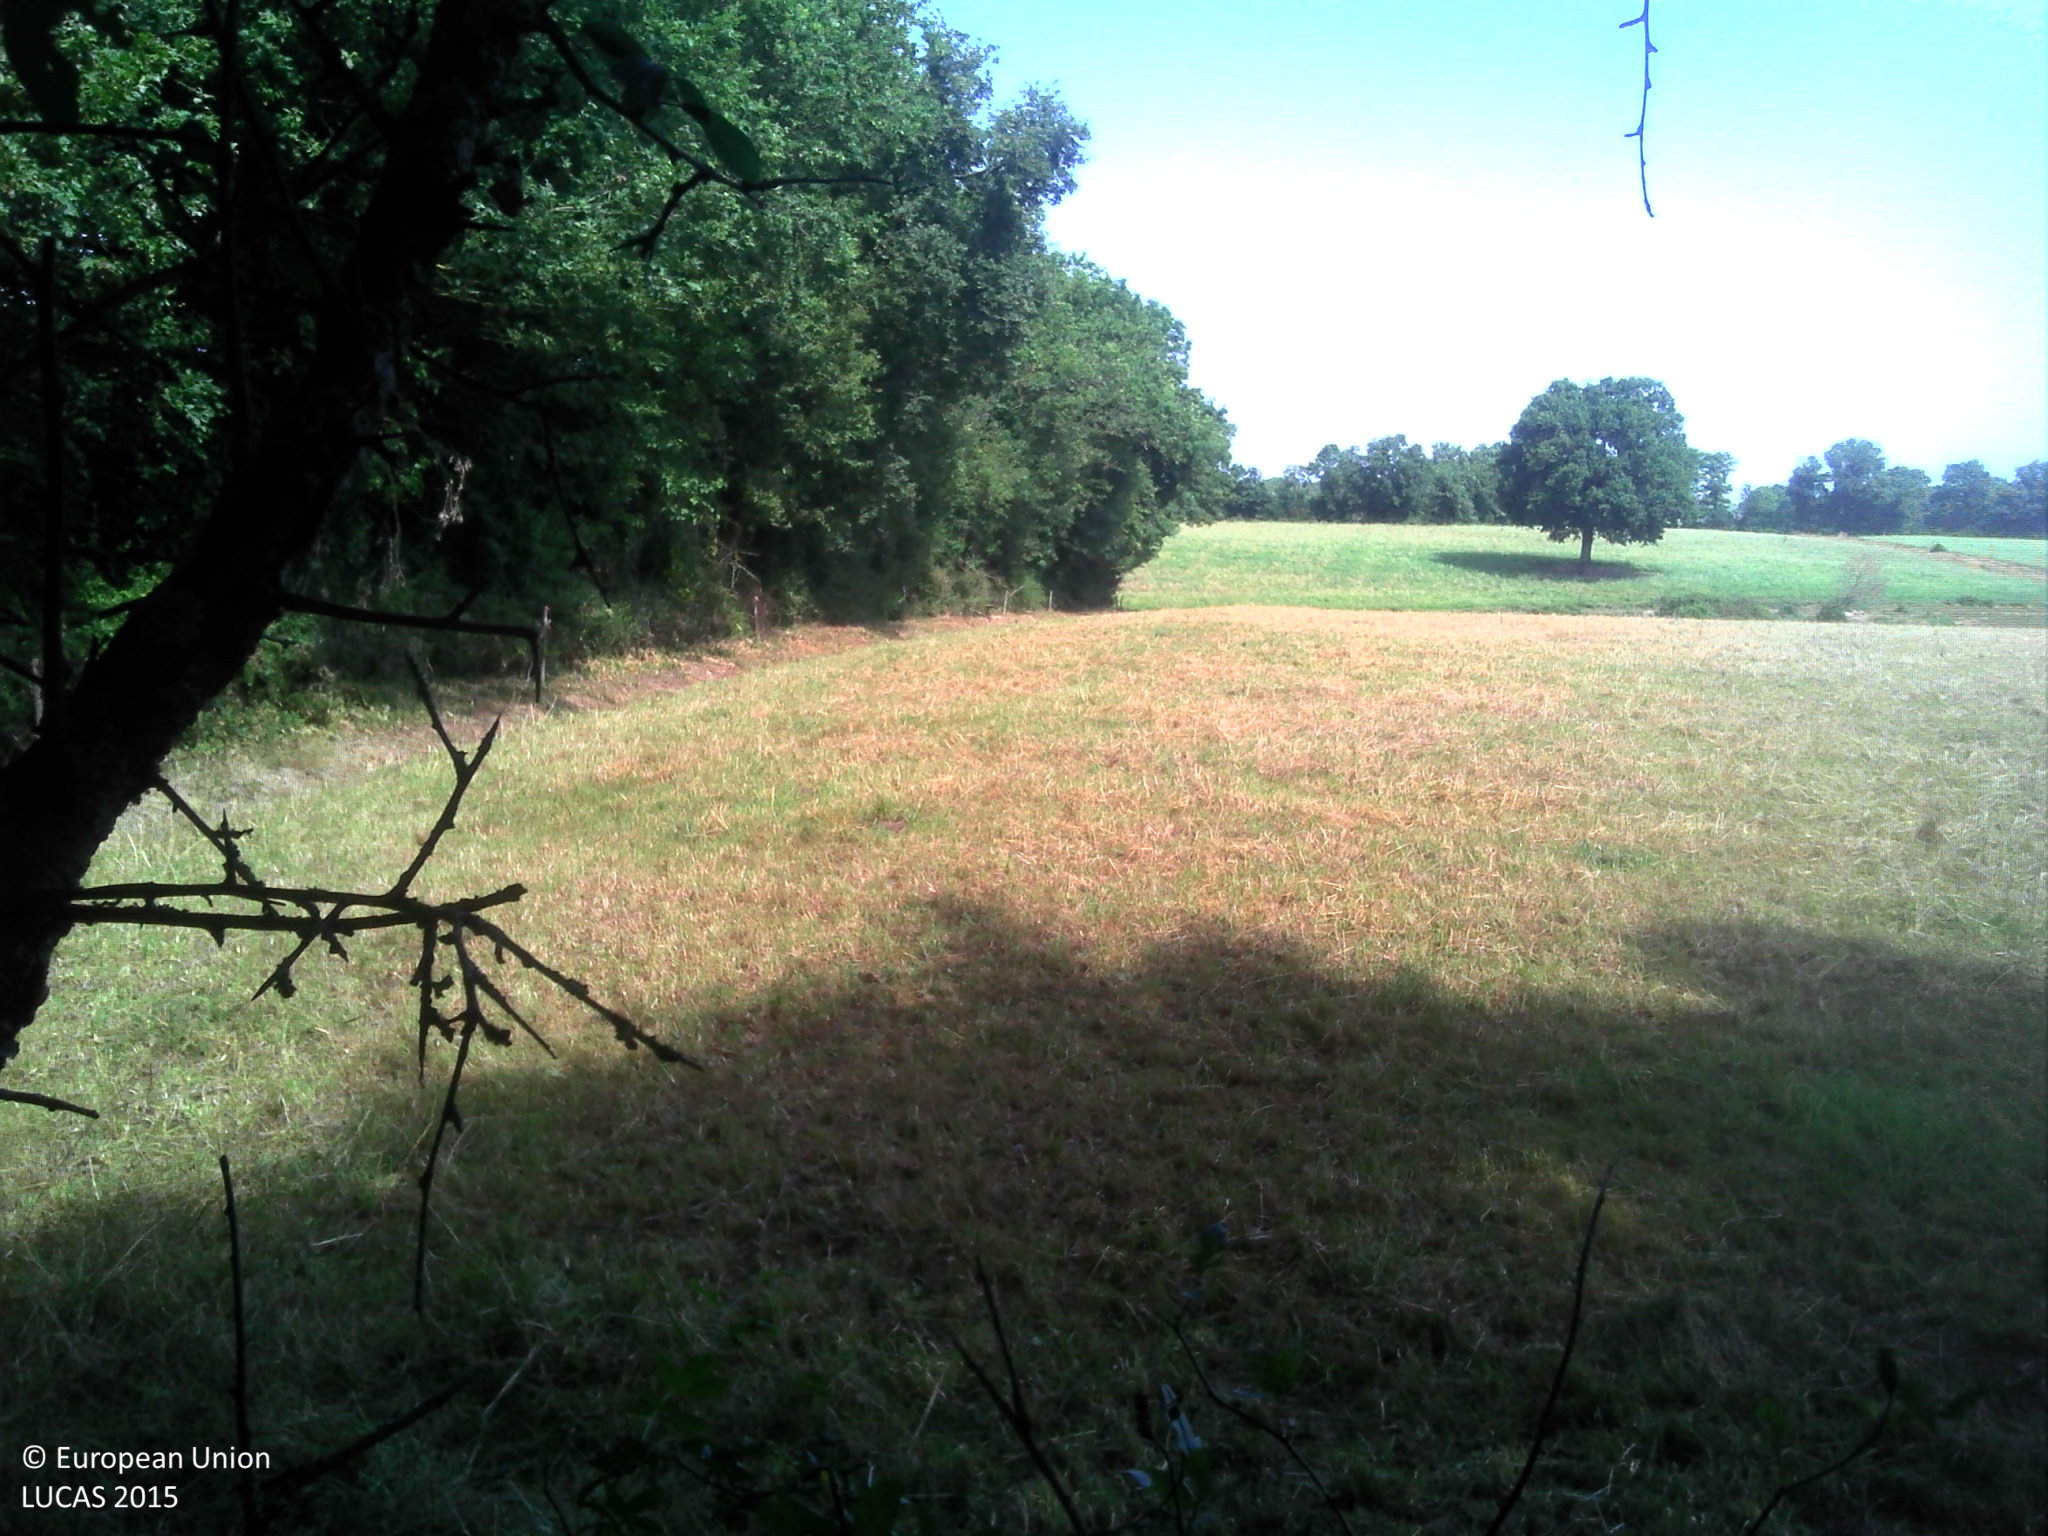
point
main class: Cropland
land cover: Temporary grasslands
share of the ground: > 75 %
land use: Agriculture (excluding fallow land and kitchen gardens)
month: July
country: FR
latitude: 46.5740
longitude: -1.5867
